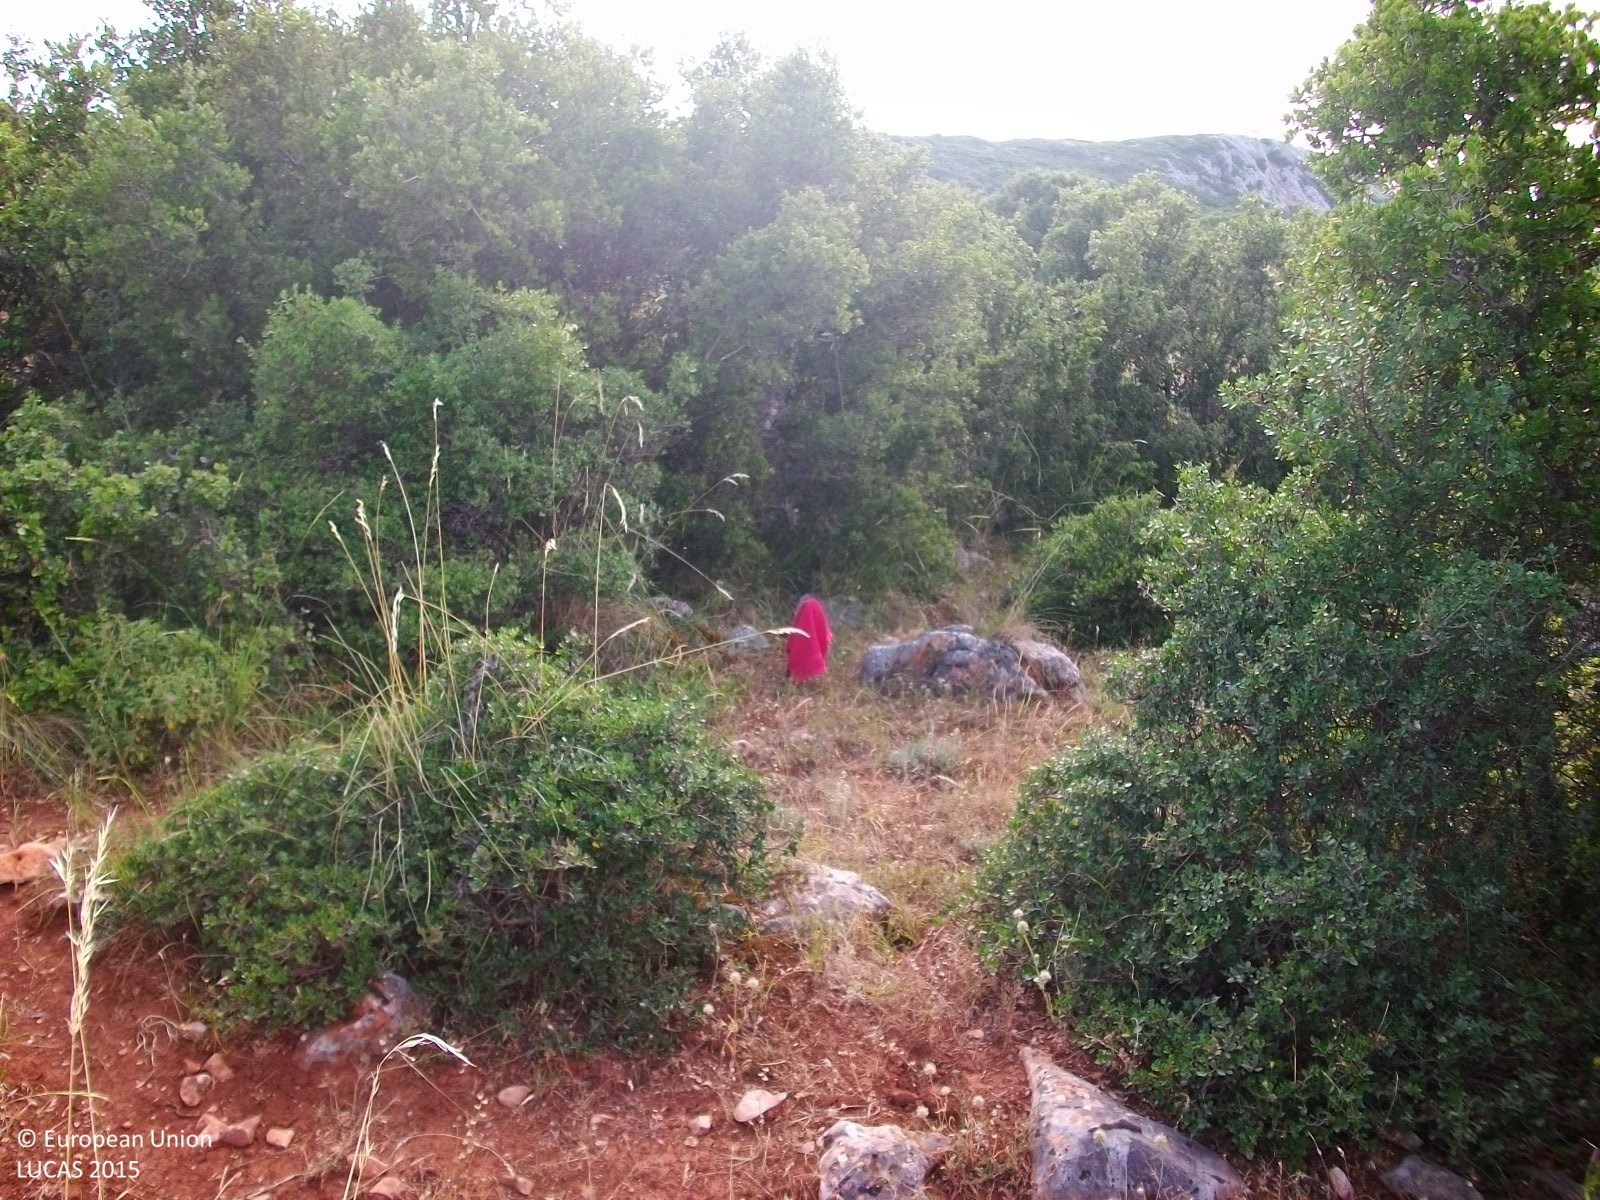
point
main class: Shrubland
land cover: Shrubland without tree cover
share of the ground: > 75 %
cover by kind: shrubs 85 %, unconsolidated bare surface 10 %, herbaceous plants 5 %
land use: Agriculture (excluding fallow land and kitchen gardens)
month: June
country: GR
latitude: 39.1301
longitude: 22.2557
